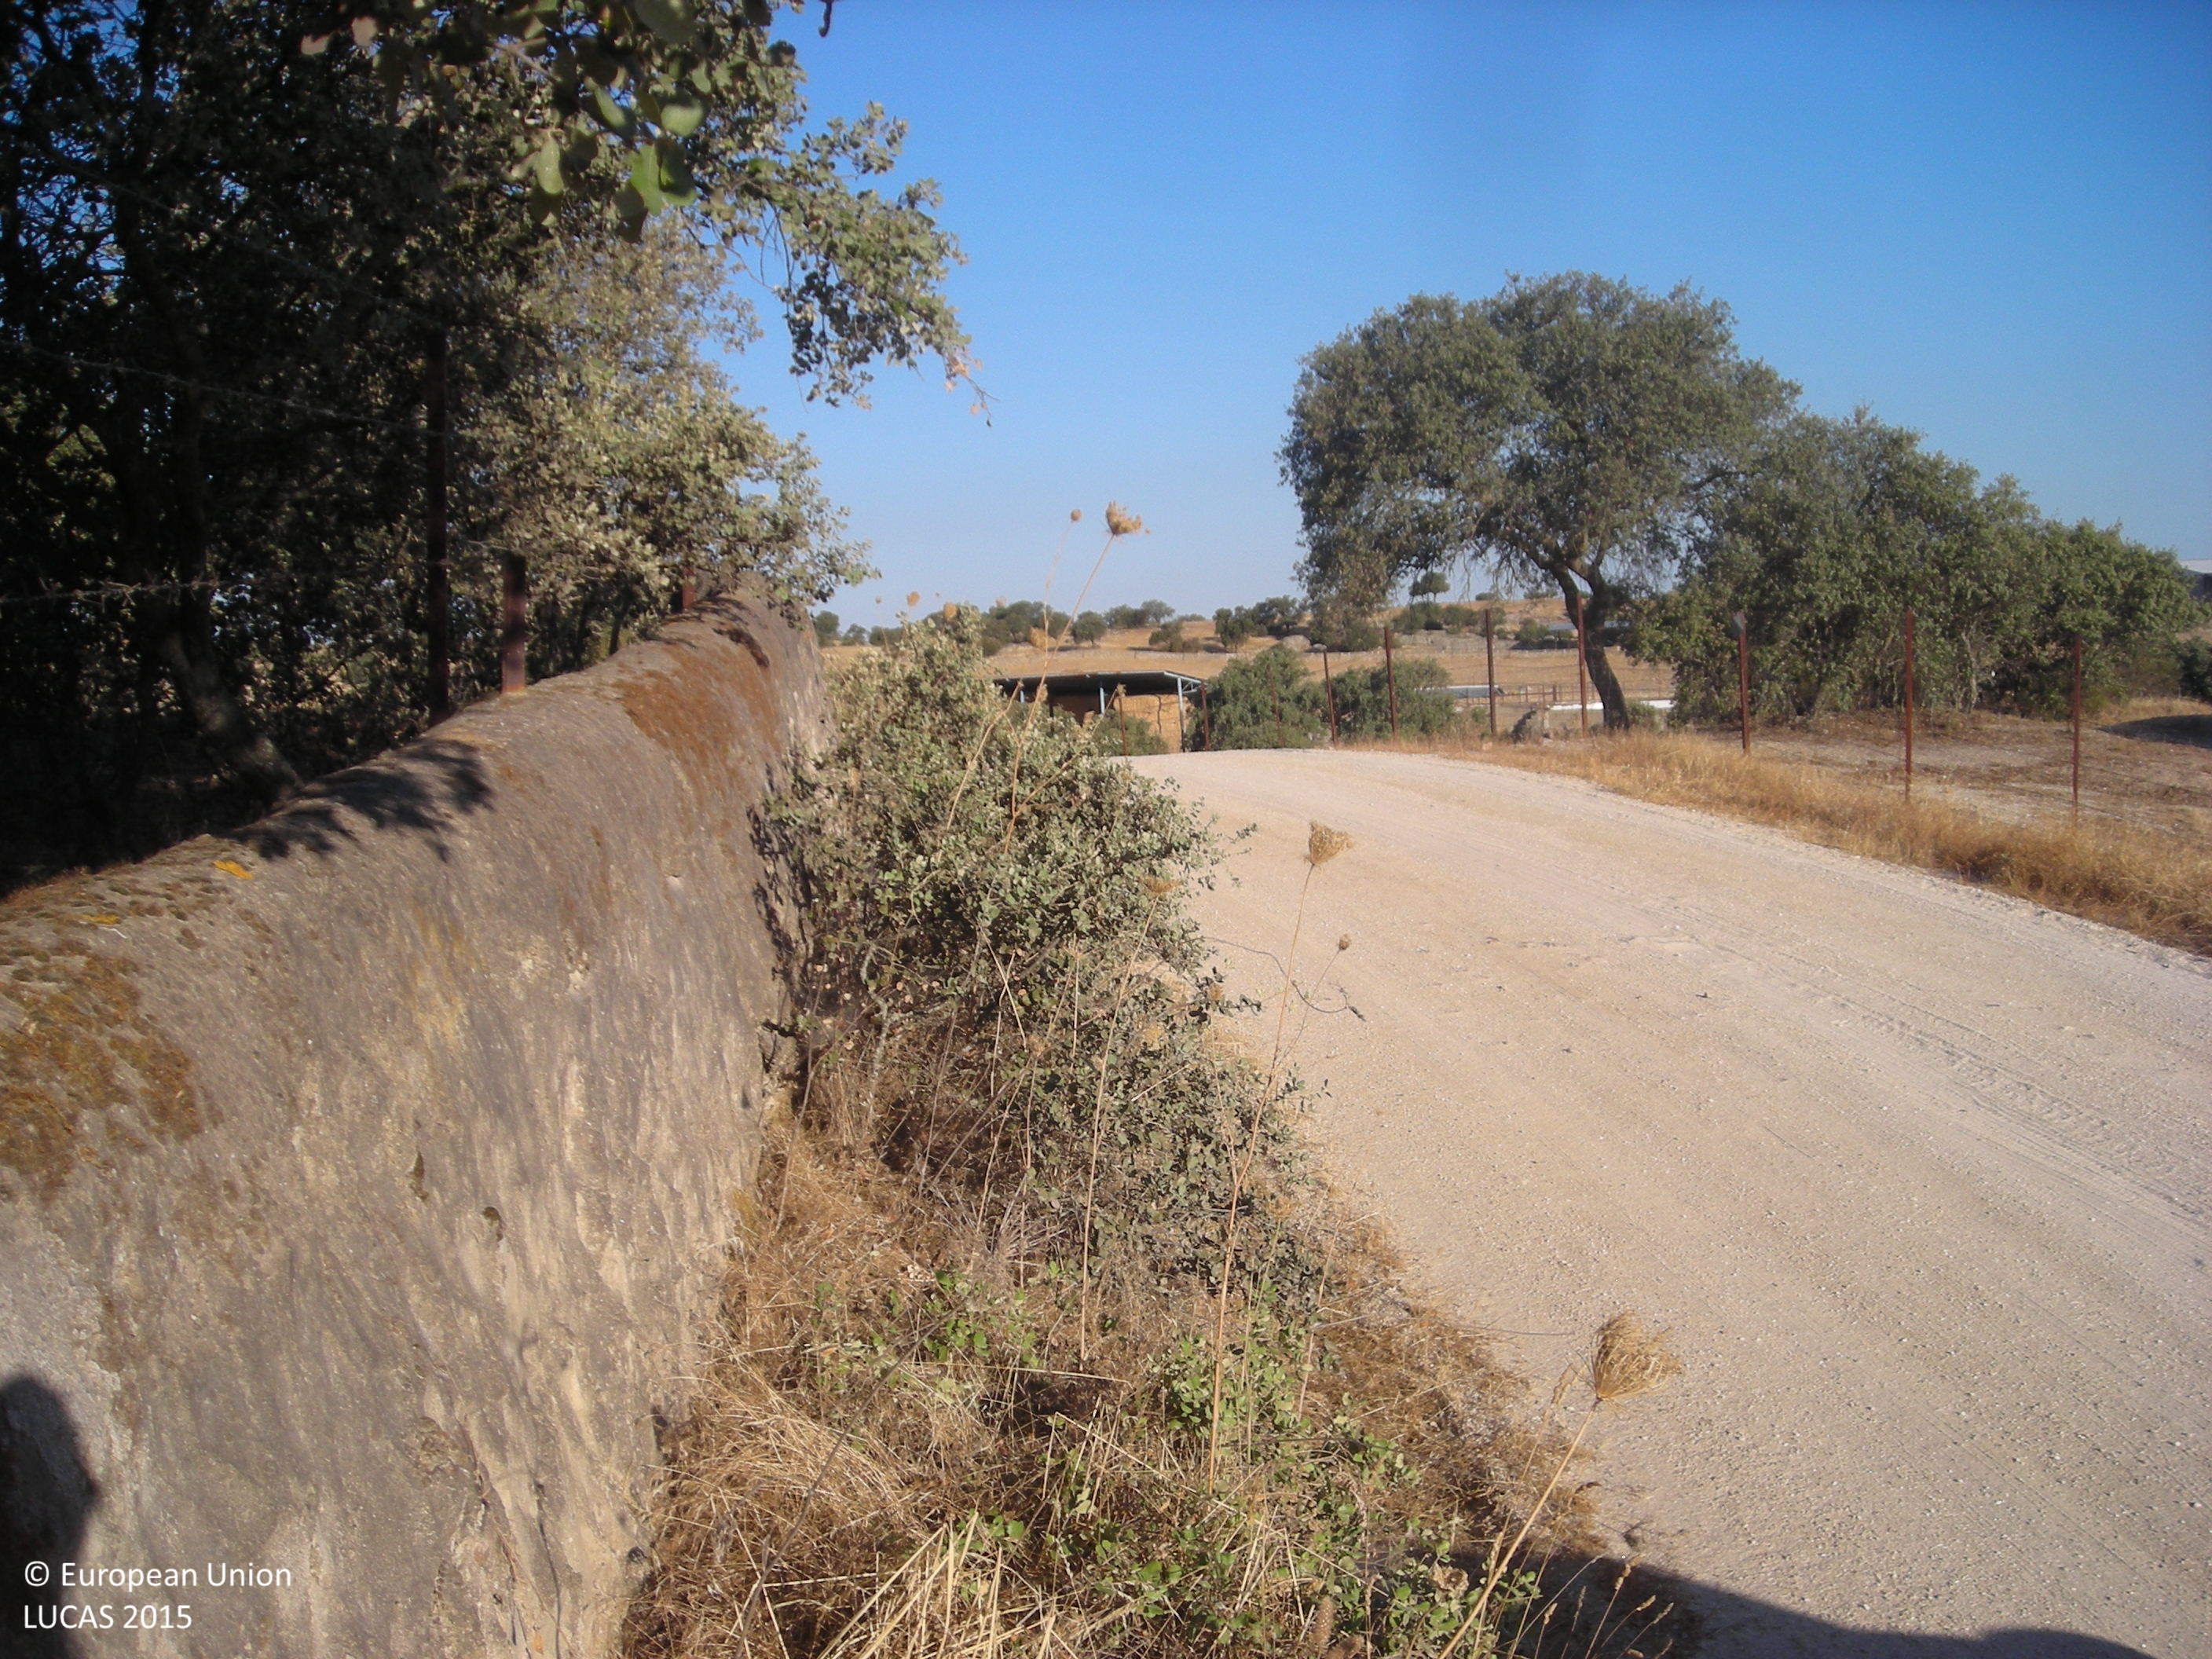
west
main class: Woodland
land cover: Broadleaved woodland
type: broadleaved evergreen forest
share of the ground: 10 - 25 %
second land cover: Grassland without tree/shrub cover
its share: > 75 %
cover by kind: herbaceous plants 60 %, broadleaved forest trees 40 %
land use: Forestry
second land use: Agriculture (excluding fallow land and kitchen gardens)
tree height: > 5 m
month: July
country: ES
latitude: 38.8952
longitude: -5.8554
